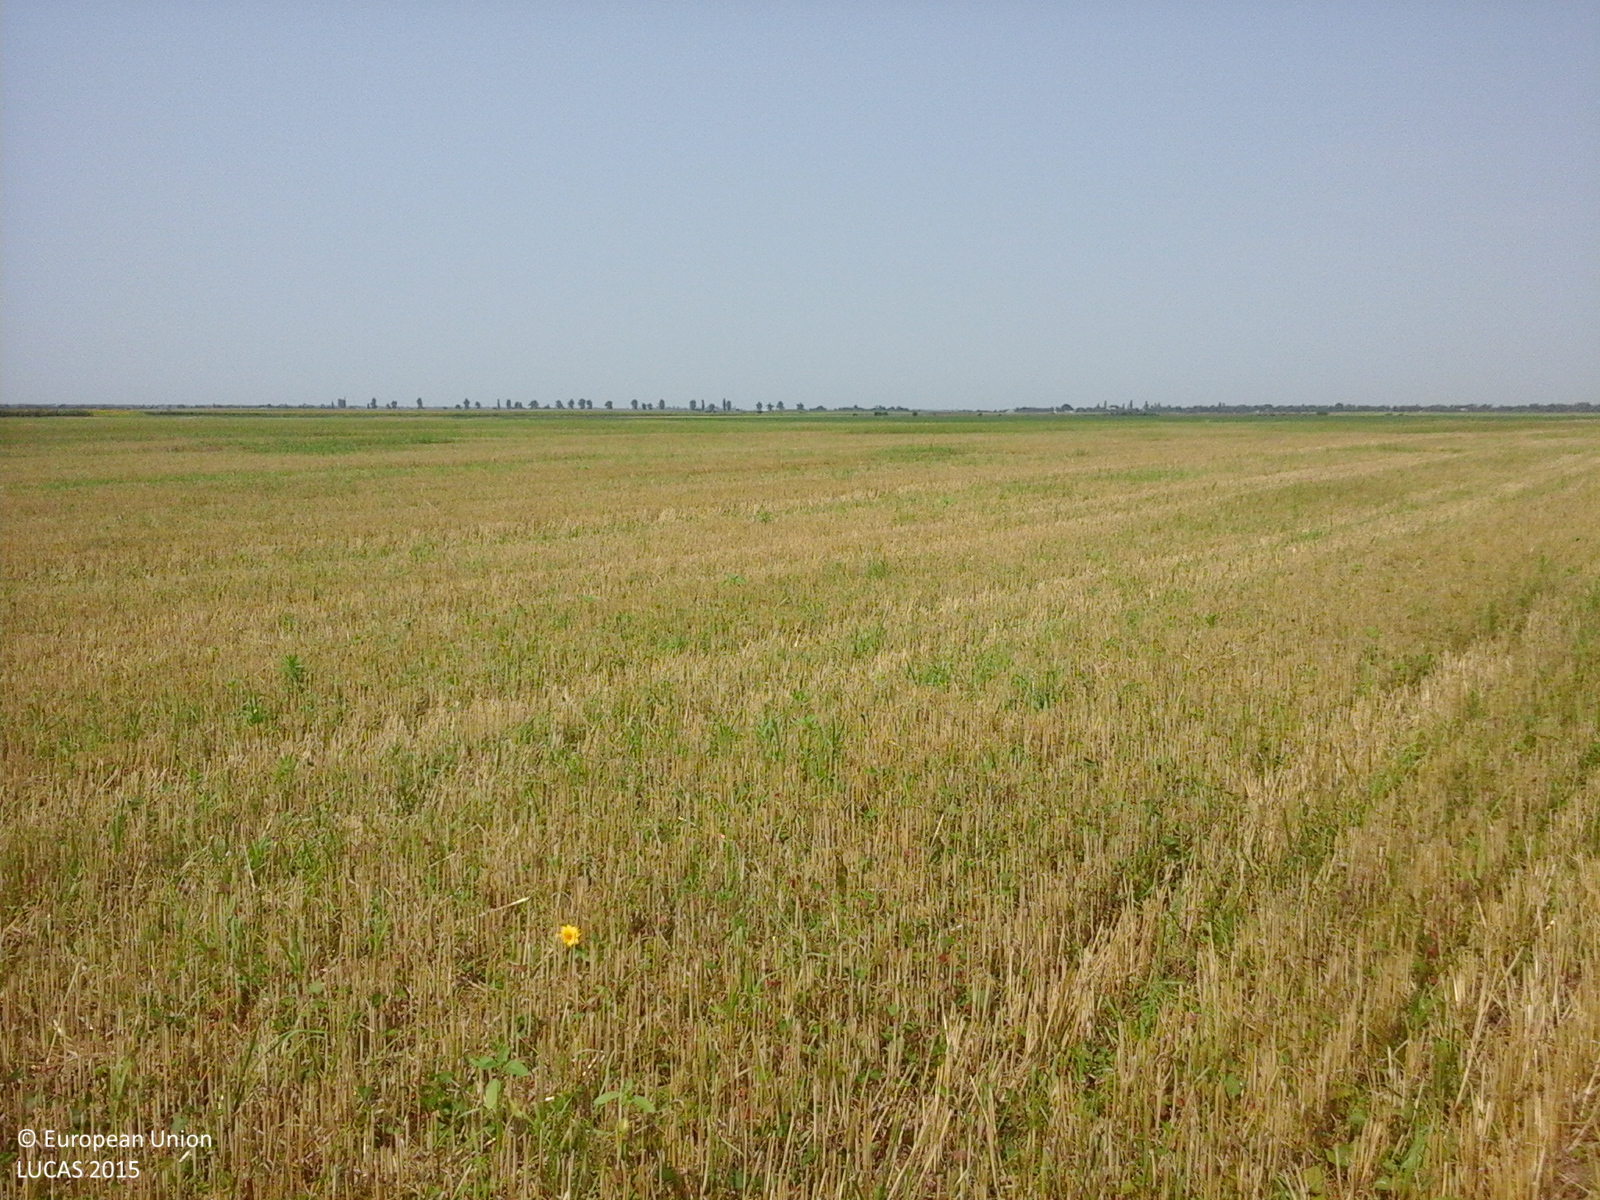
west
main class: Cropland
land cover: Common wheat
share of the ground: 50 - 75 %
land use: Agriculture (excluding fallow land and kitchen gardens)
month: July
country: RO
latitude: 44.7653
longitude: 26.6091
